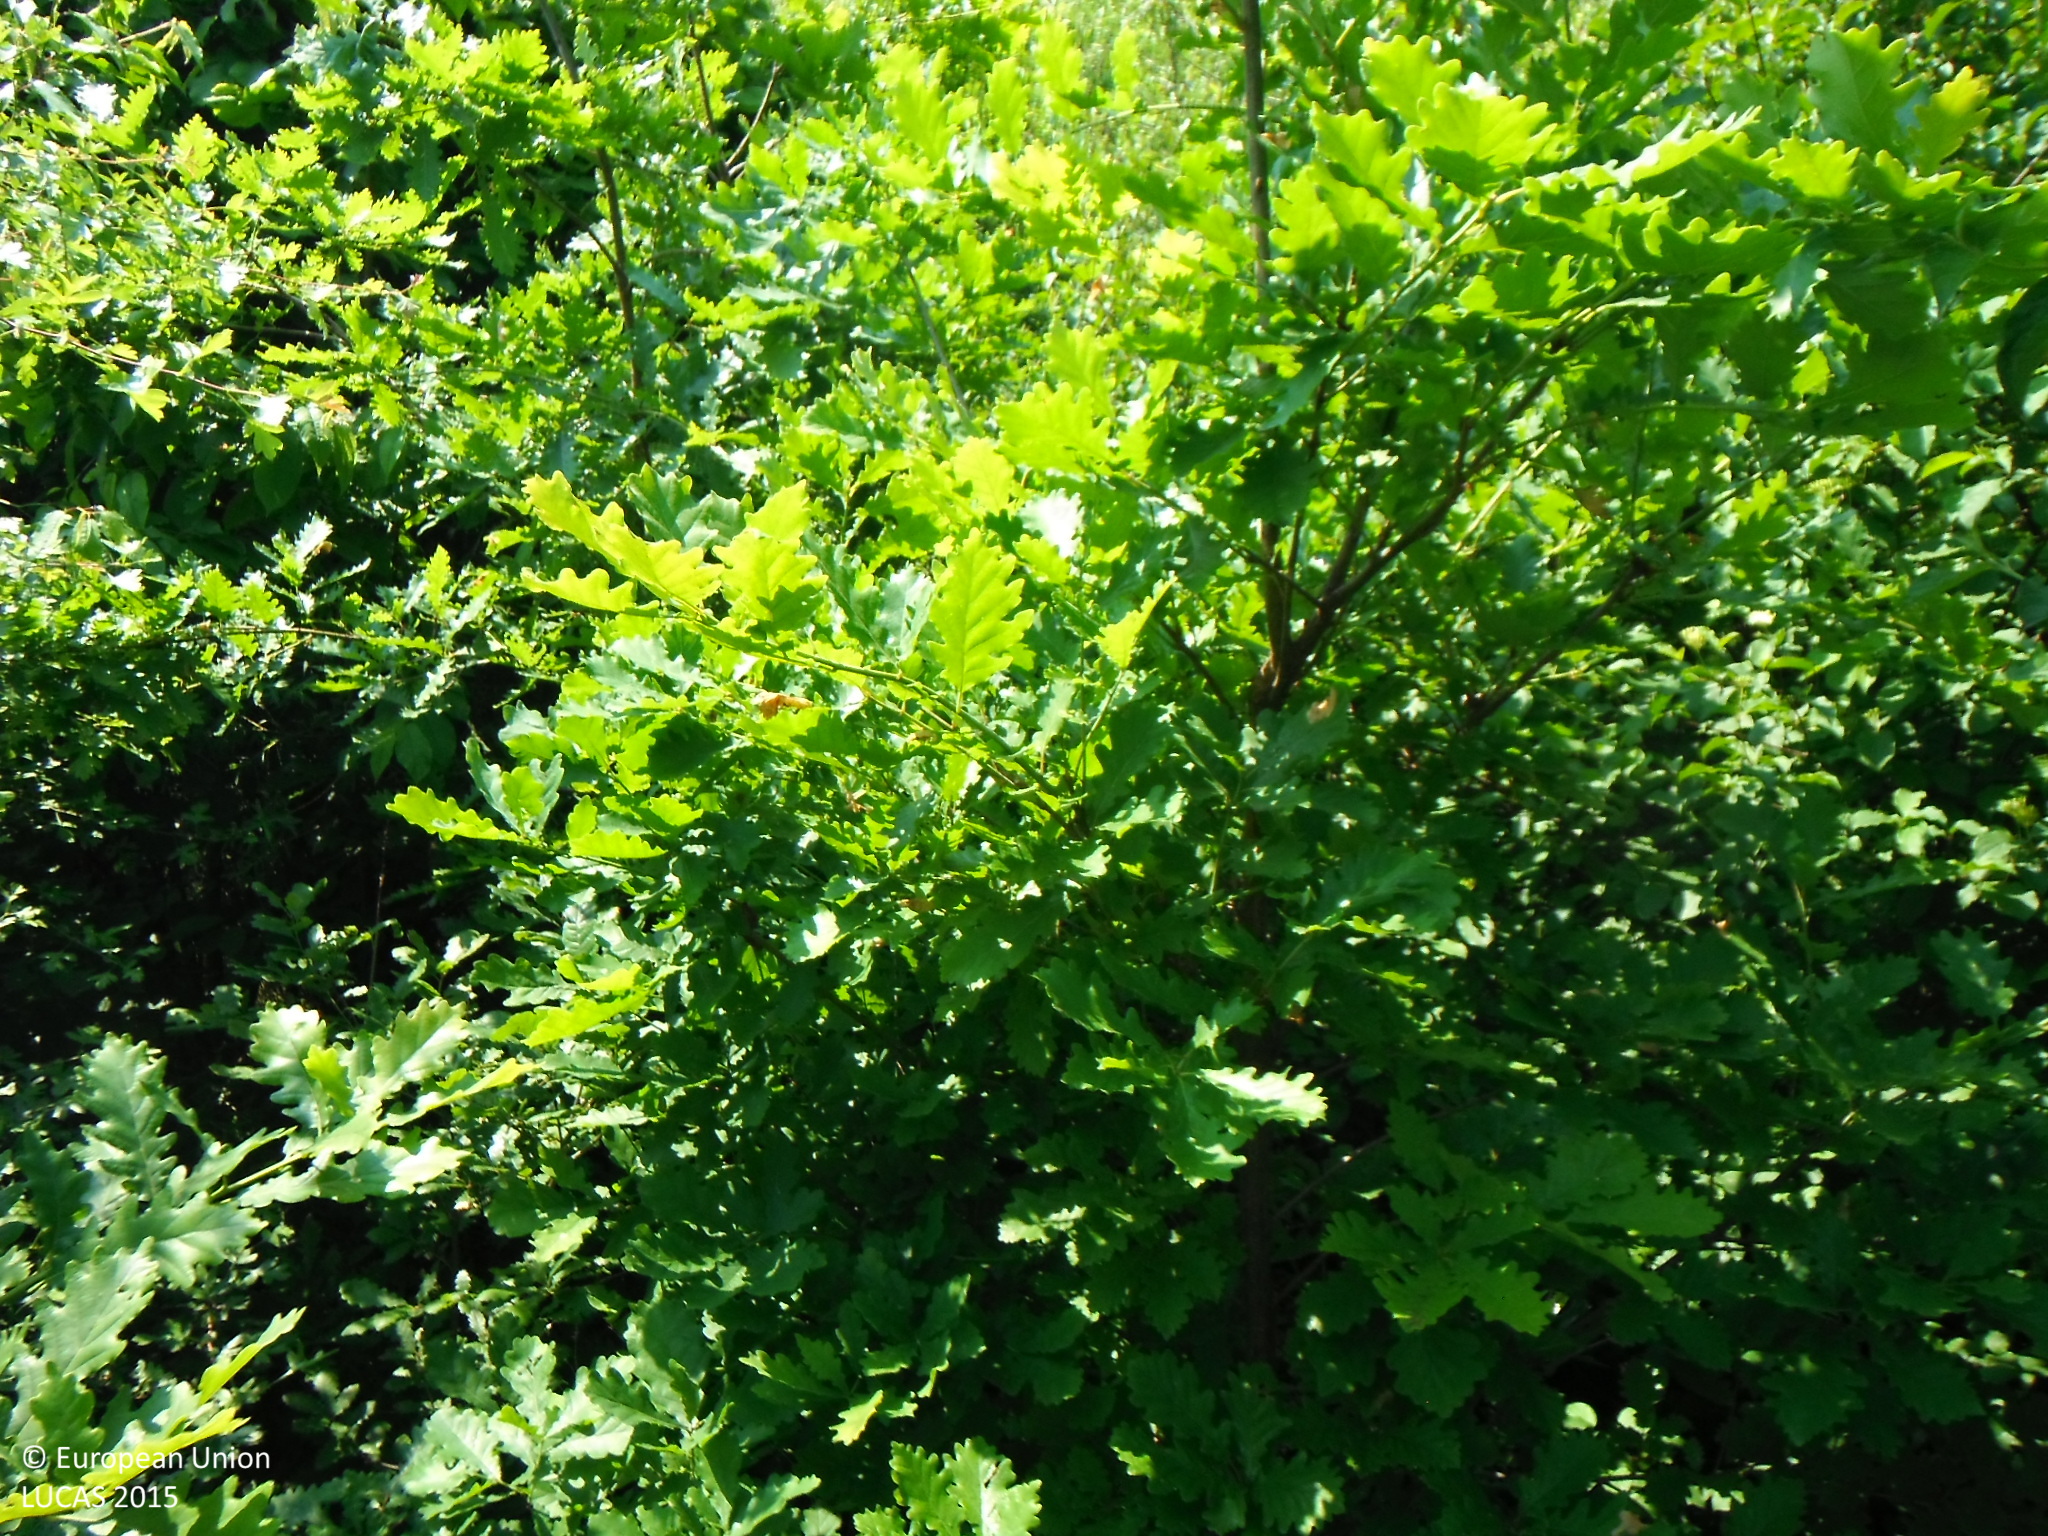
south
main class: Woodland
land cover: Broadleaved woodland
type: mesophytic deciduous forest
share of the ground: > 75 %
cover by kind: broadleaved forest trees 95 %, coniferous forest trees 5 %
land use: Forestry
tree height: > 5 m
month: June
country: SK
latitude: 48.8485
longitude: 21.5642
